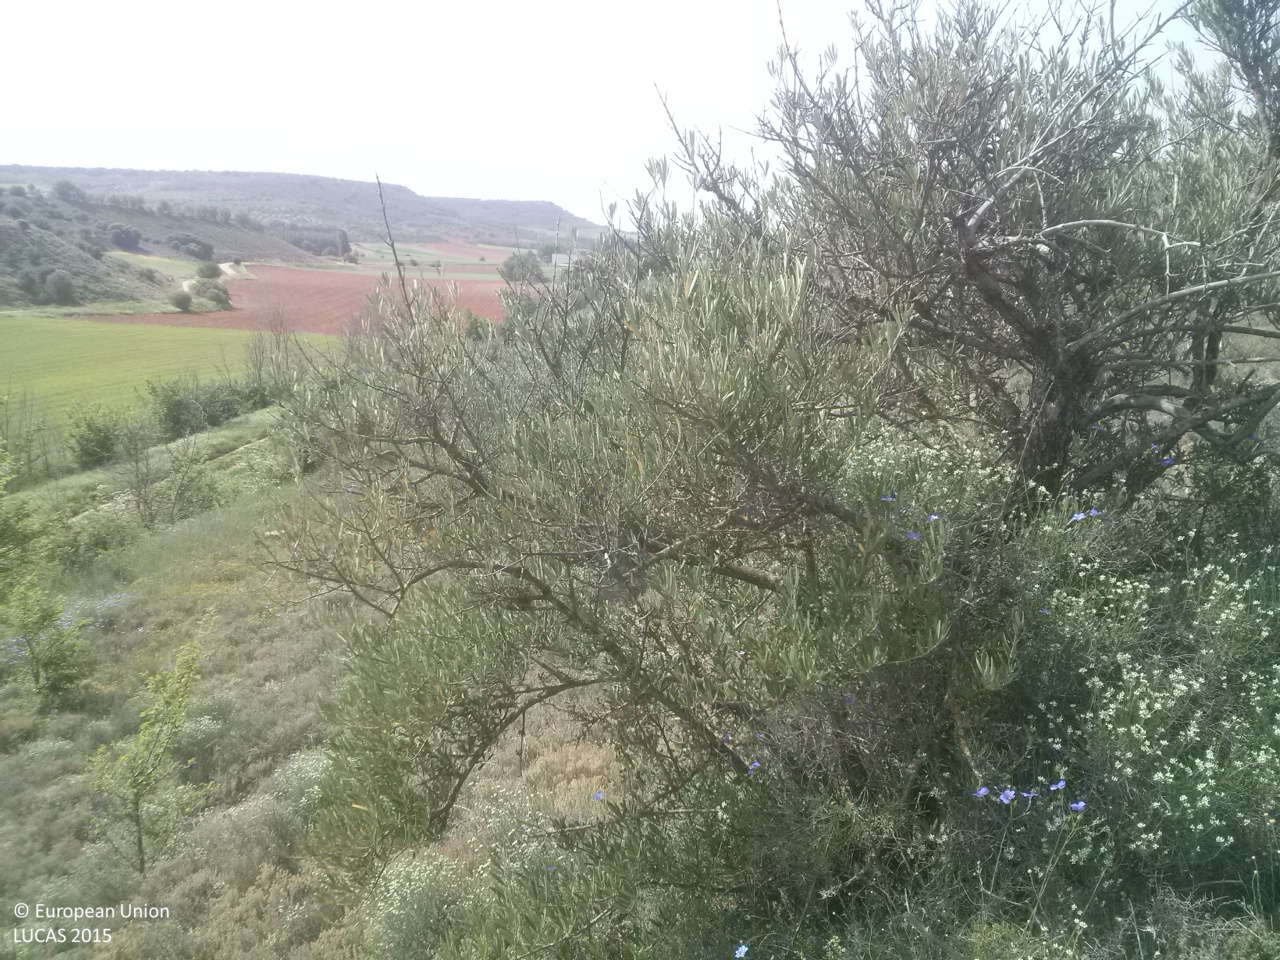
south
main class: Cropland
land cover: Olive groves
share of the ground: 10 - 25 %
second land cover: Shrubland without tree cover
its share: > 75 %
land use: Abandoned areas
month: May
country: ES
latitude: 39.9720
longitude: -2.5347
